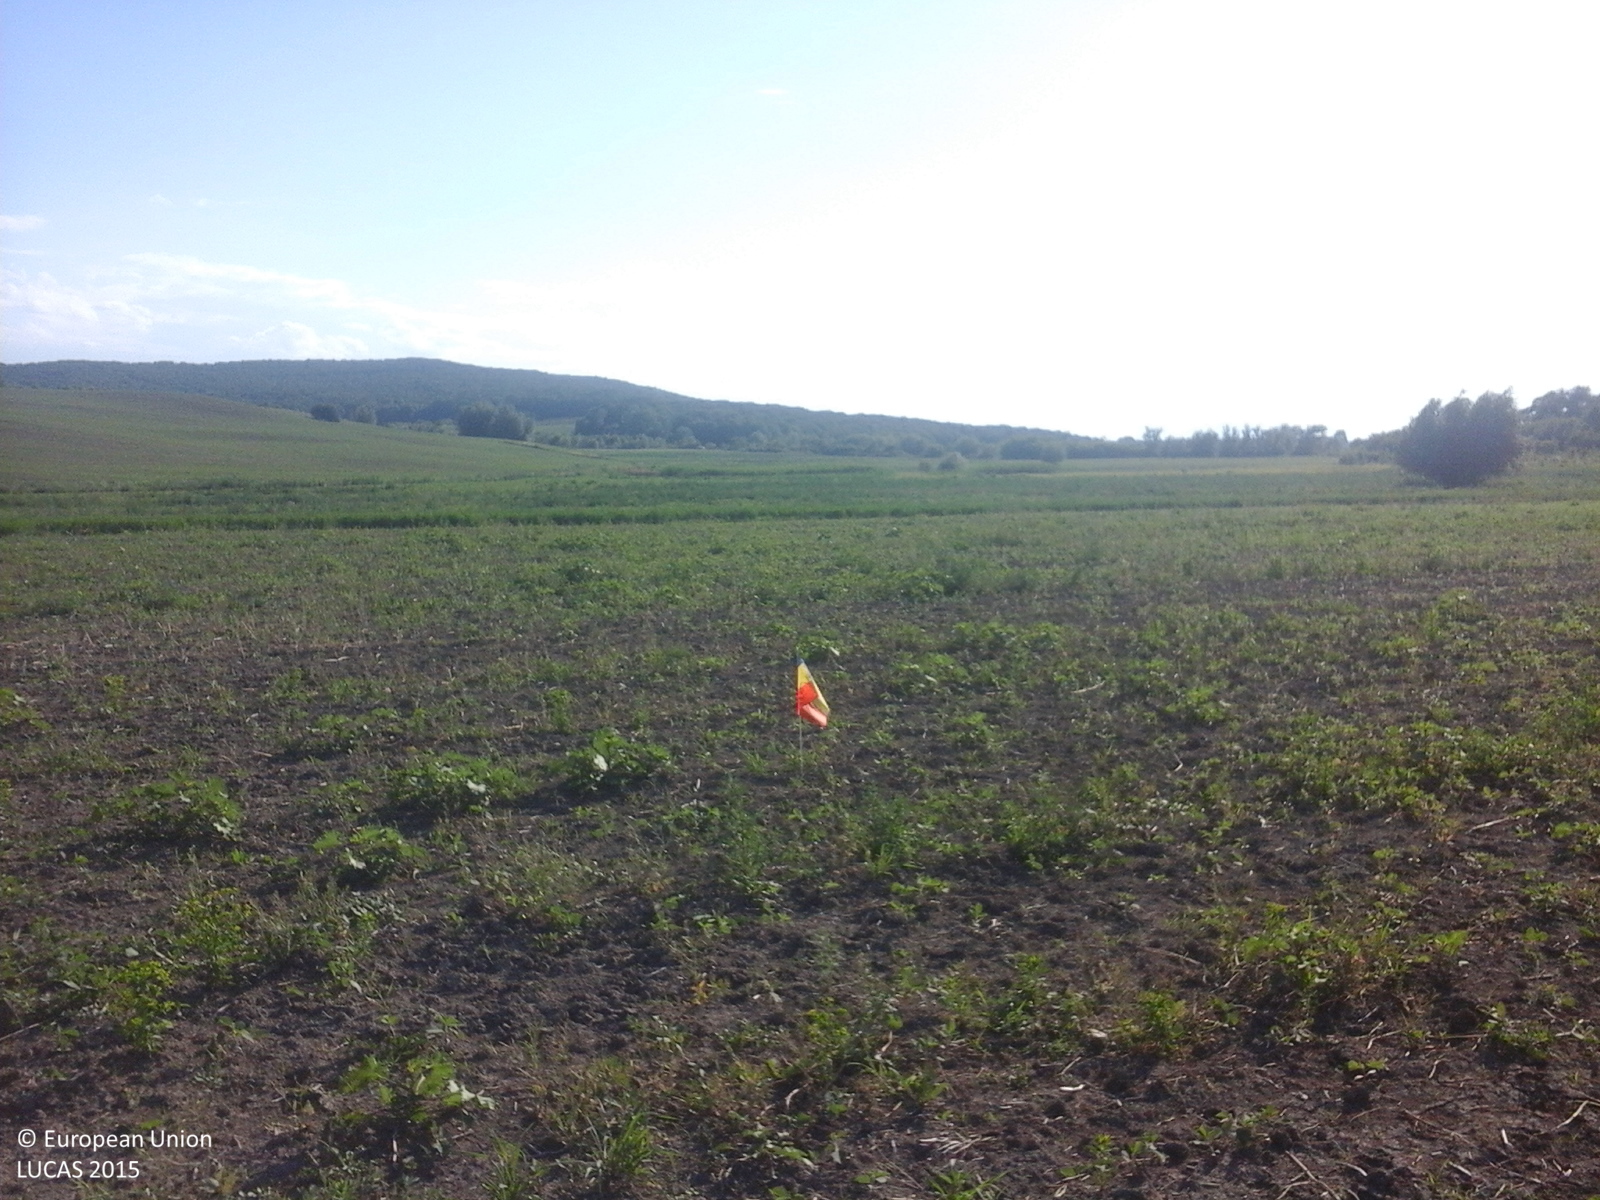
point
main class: Cropland
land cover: Soya
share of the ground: 10 - 25 %
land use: Agriculture (excluding fallow land and kitchen gardens)
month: June
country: RO
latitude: 48.2364
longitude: 26.6171
